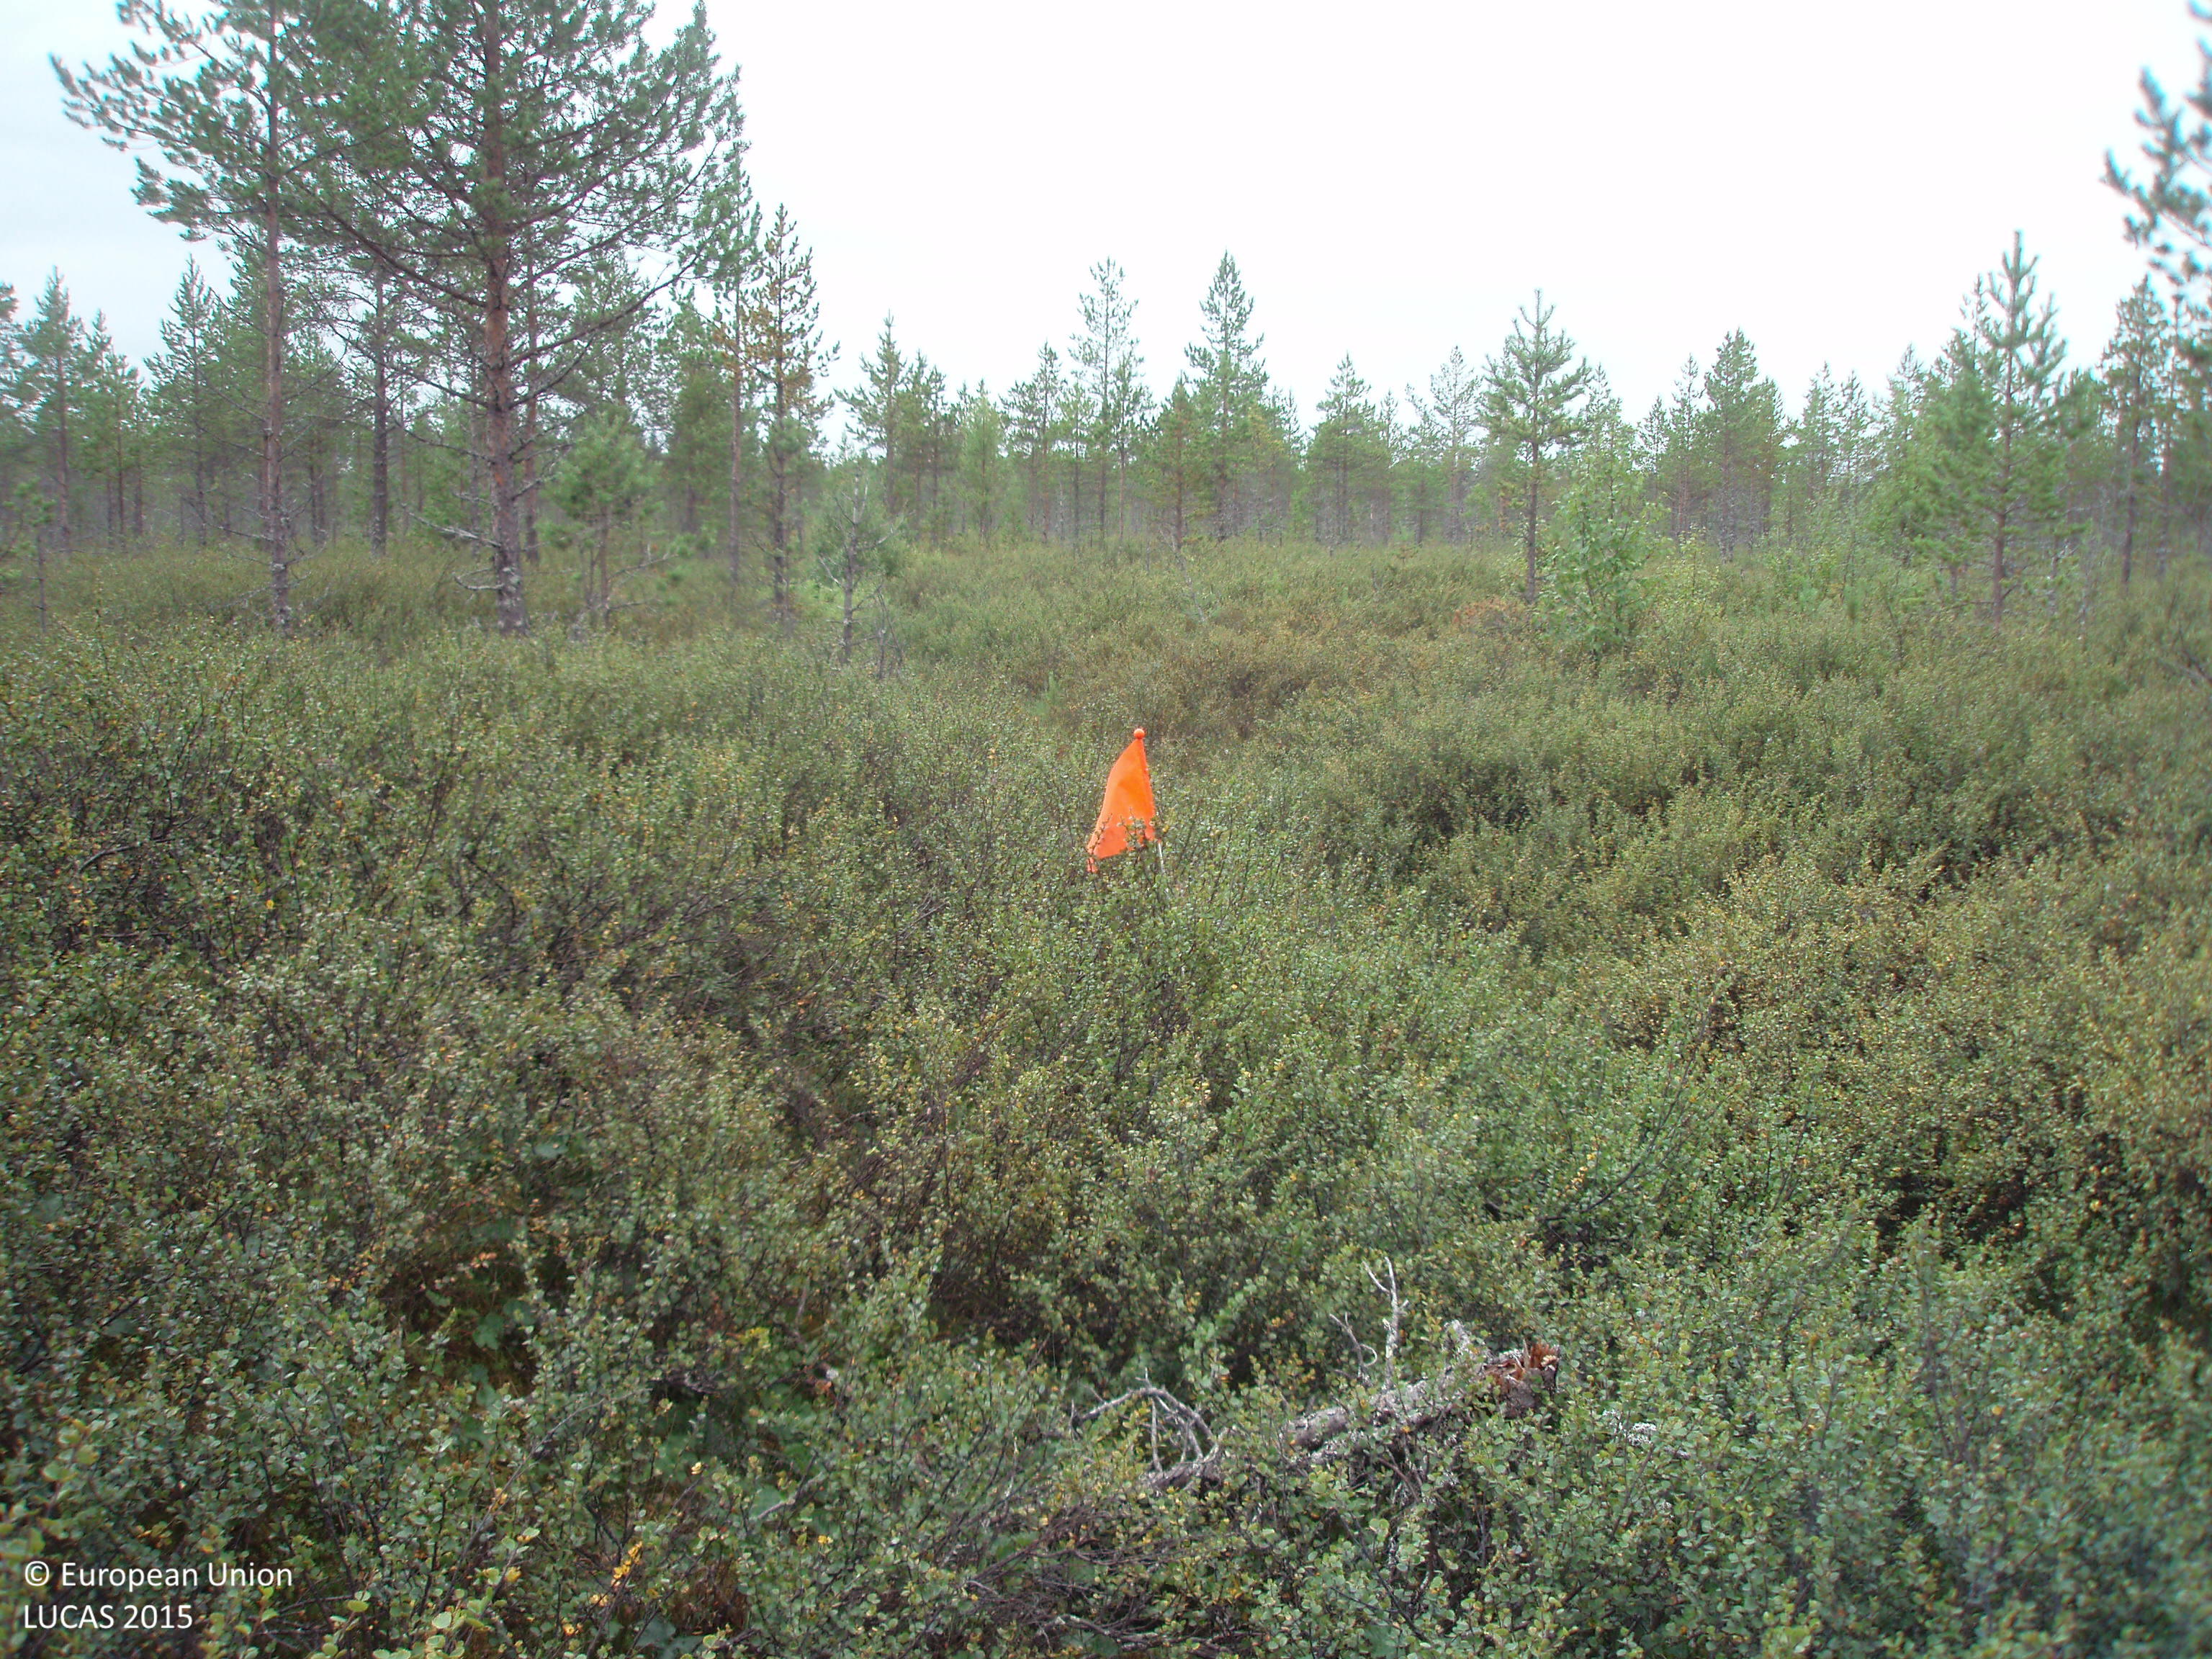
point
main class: Woodland
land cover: Pine dominated coniferous woodland
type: boreal forest
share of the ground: 10 - 25 %
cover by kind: shrubs 80 %, coniferous forest trees 20 %
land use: Forestry
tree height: > 5 m
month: August
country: FI
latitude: 65.4712
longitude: 27.0632
